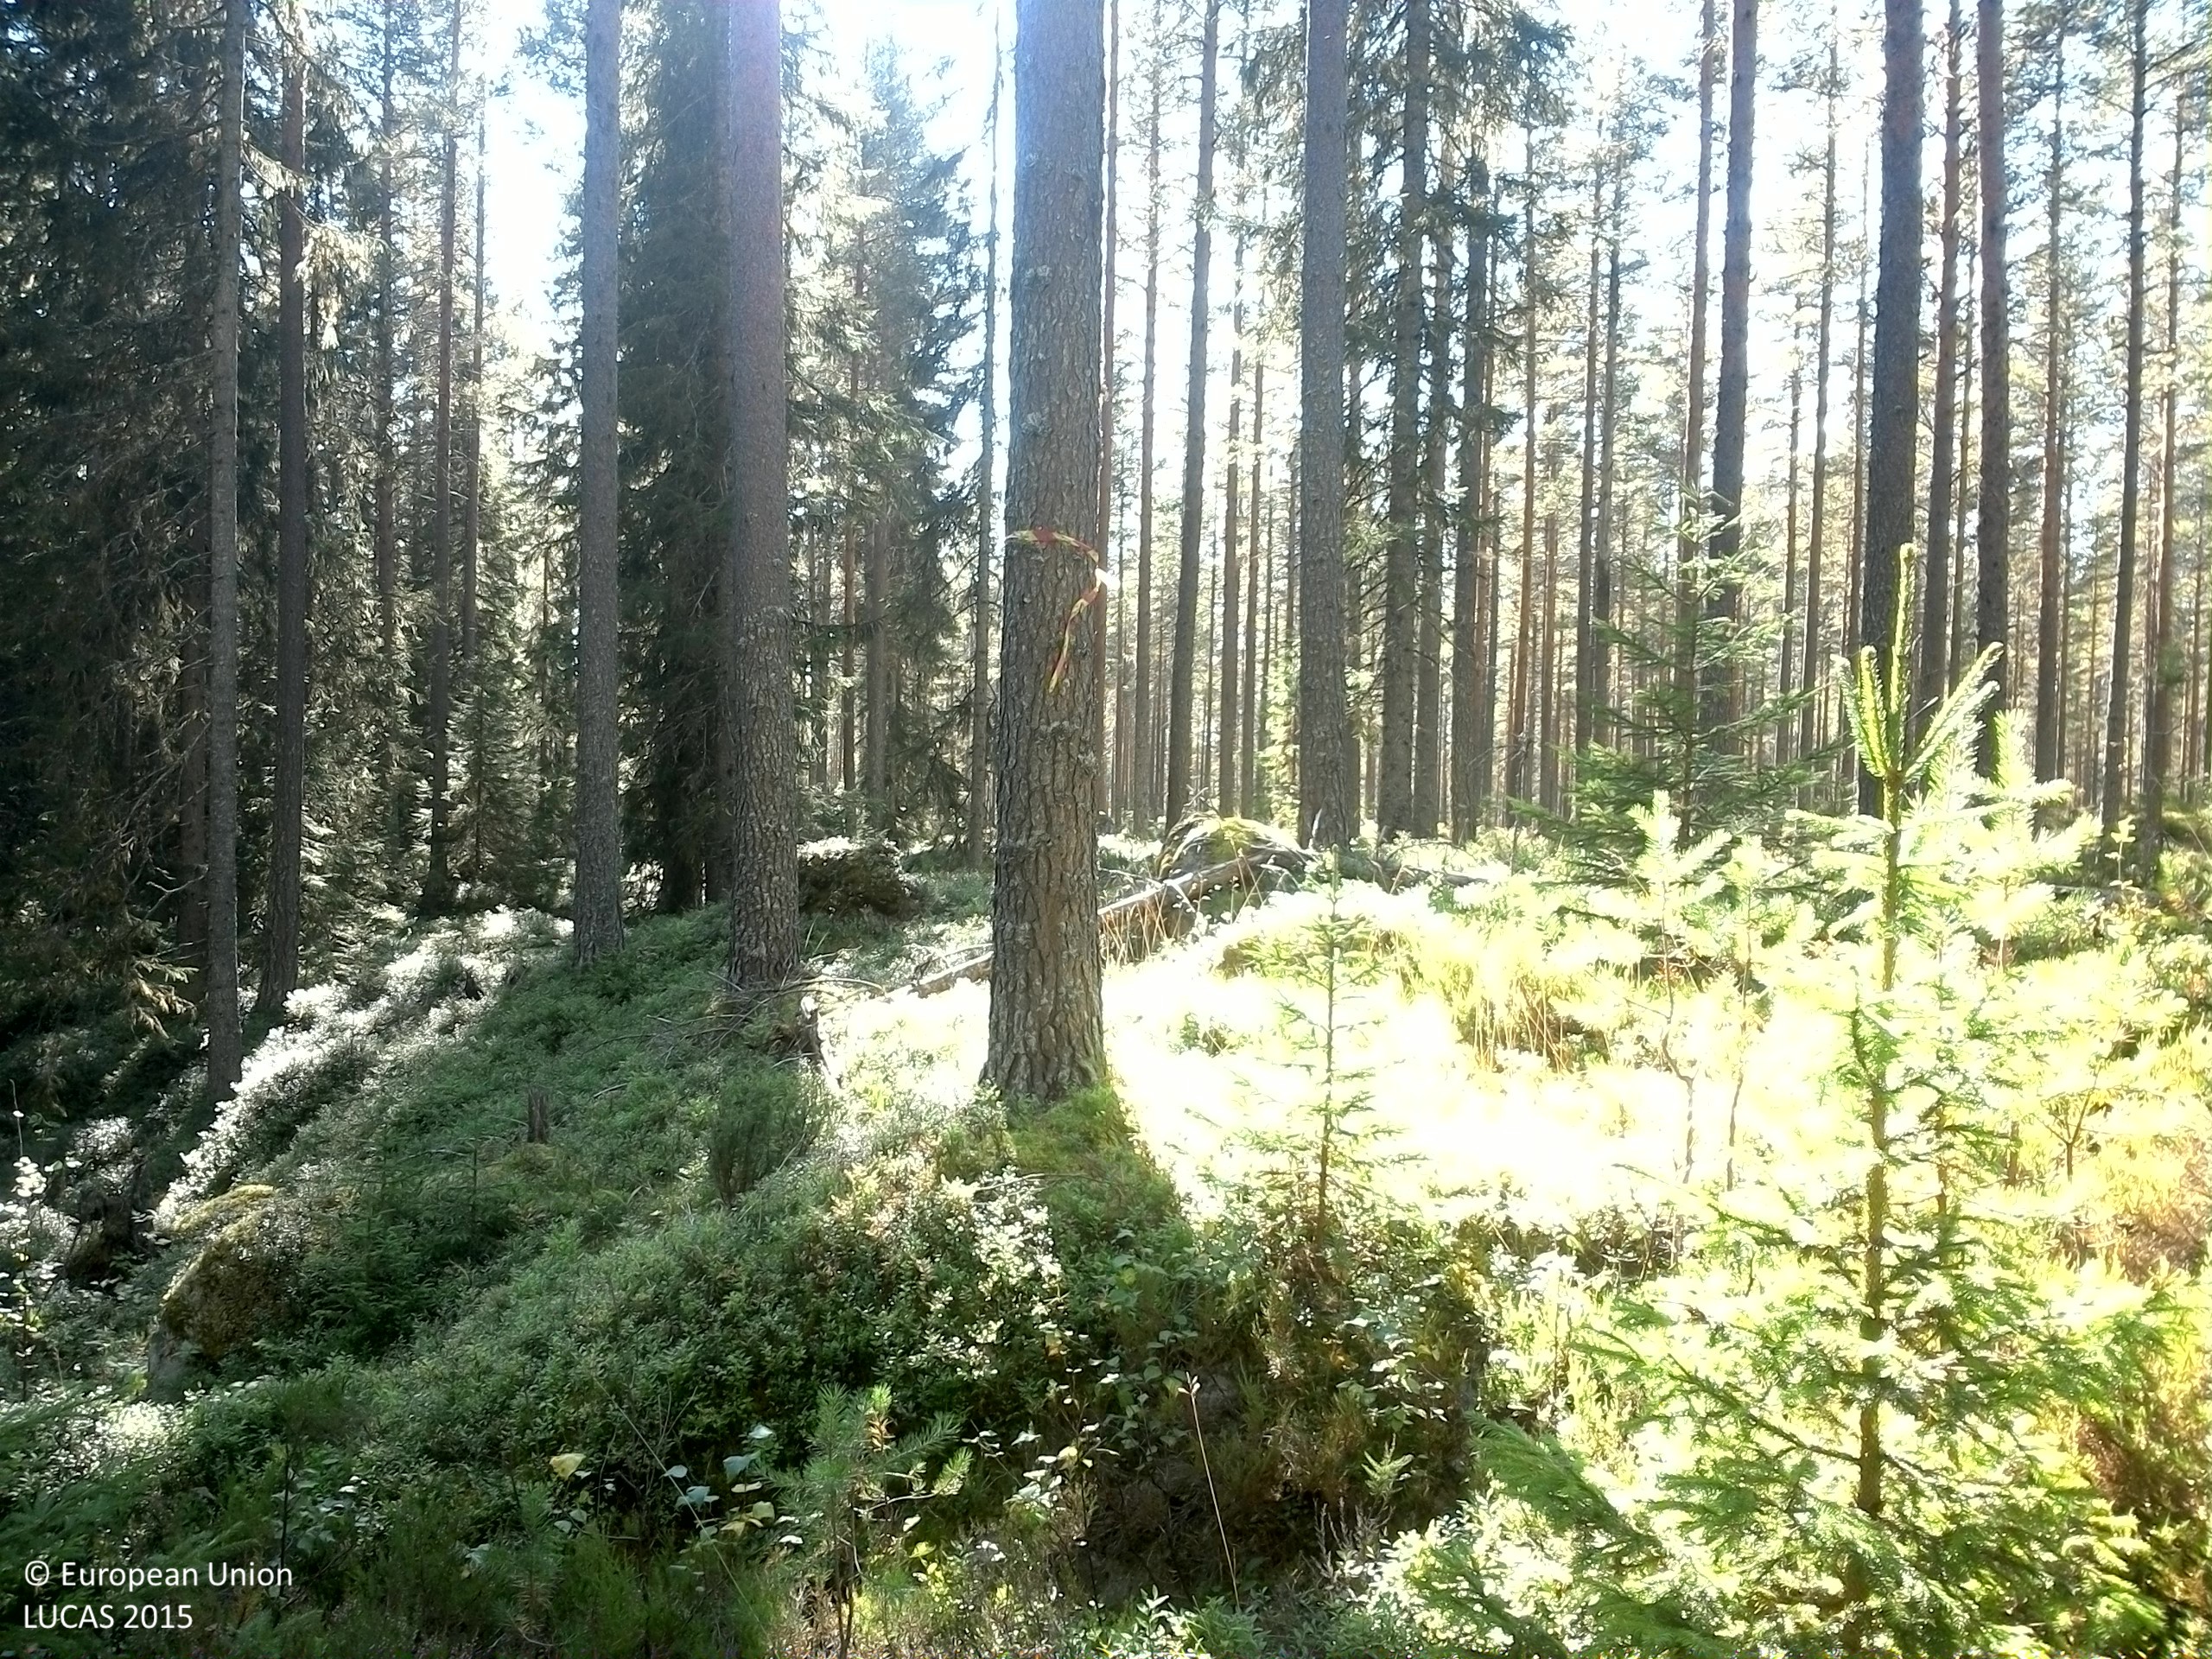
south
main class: Woodland
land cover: Pine dominated coniferous woodland
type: boreal forest
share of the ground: 50 - 75 %
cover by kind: coniferous forest trees 50 %, shrubs 35 %, lichens and mosses 15 %
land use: Forestry
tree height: > 5 m
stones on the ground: 10 - 25 %
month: September
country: SE
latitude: 61.7551
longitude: 14.9274
